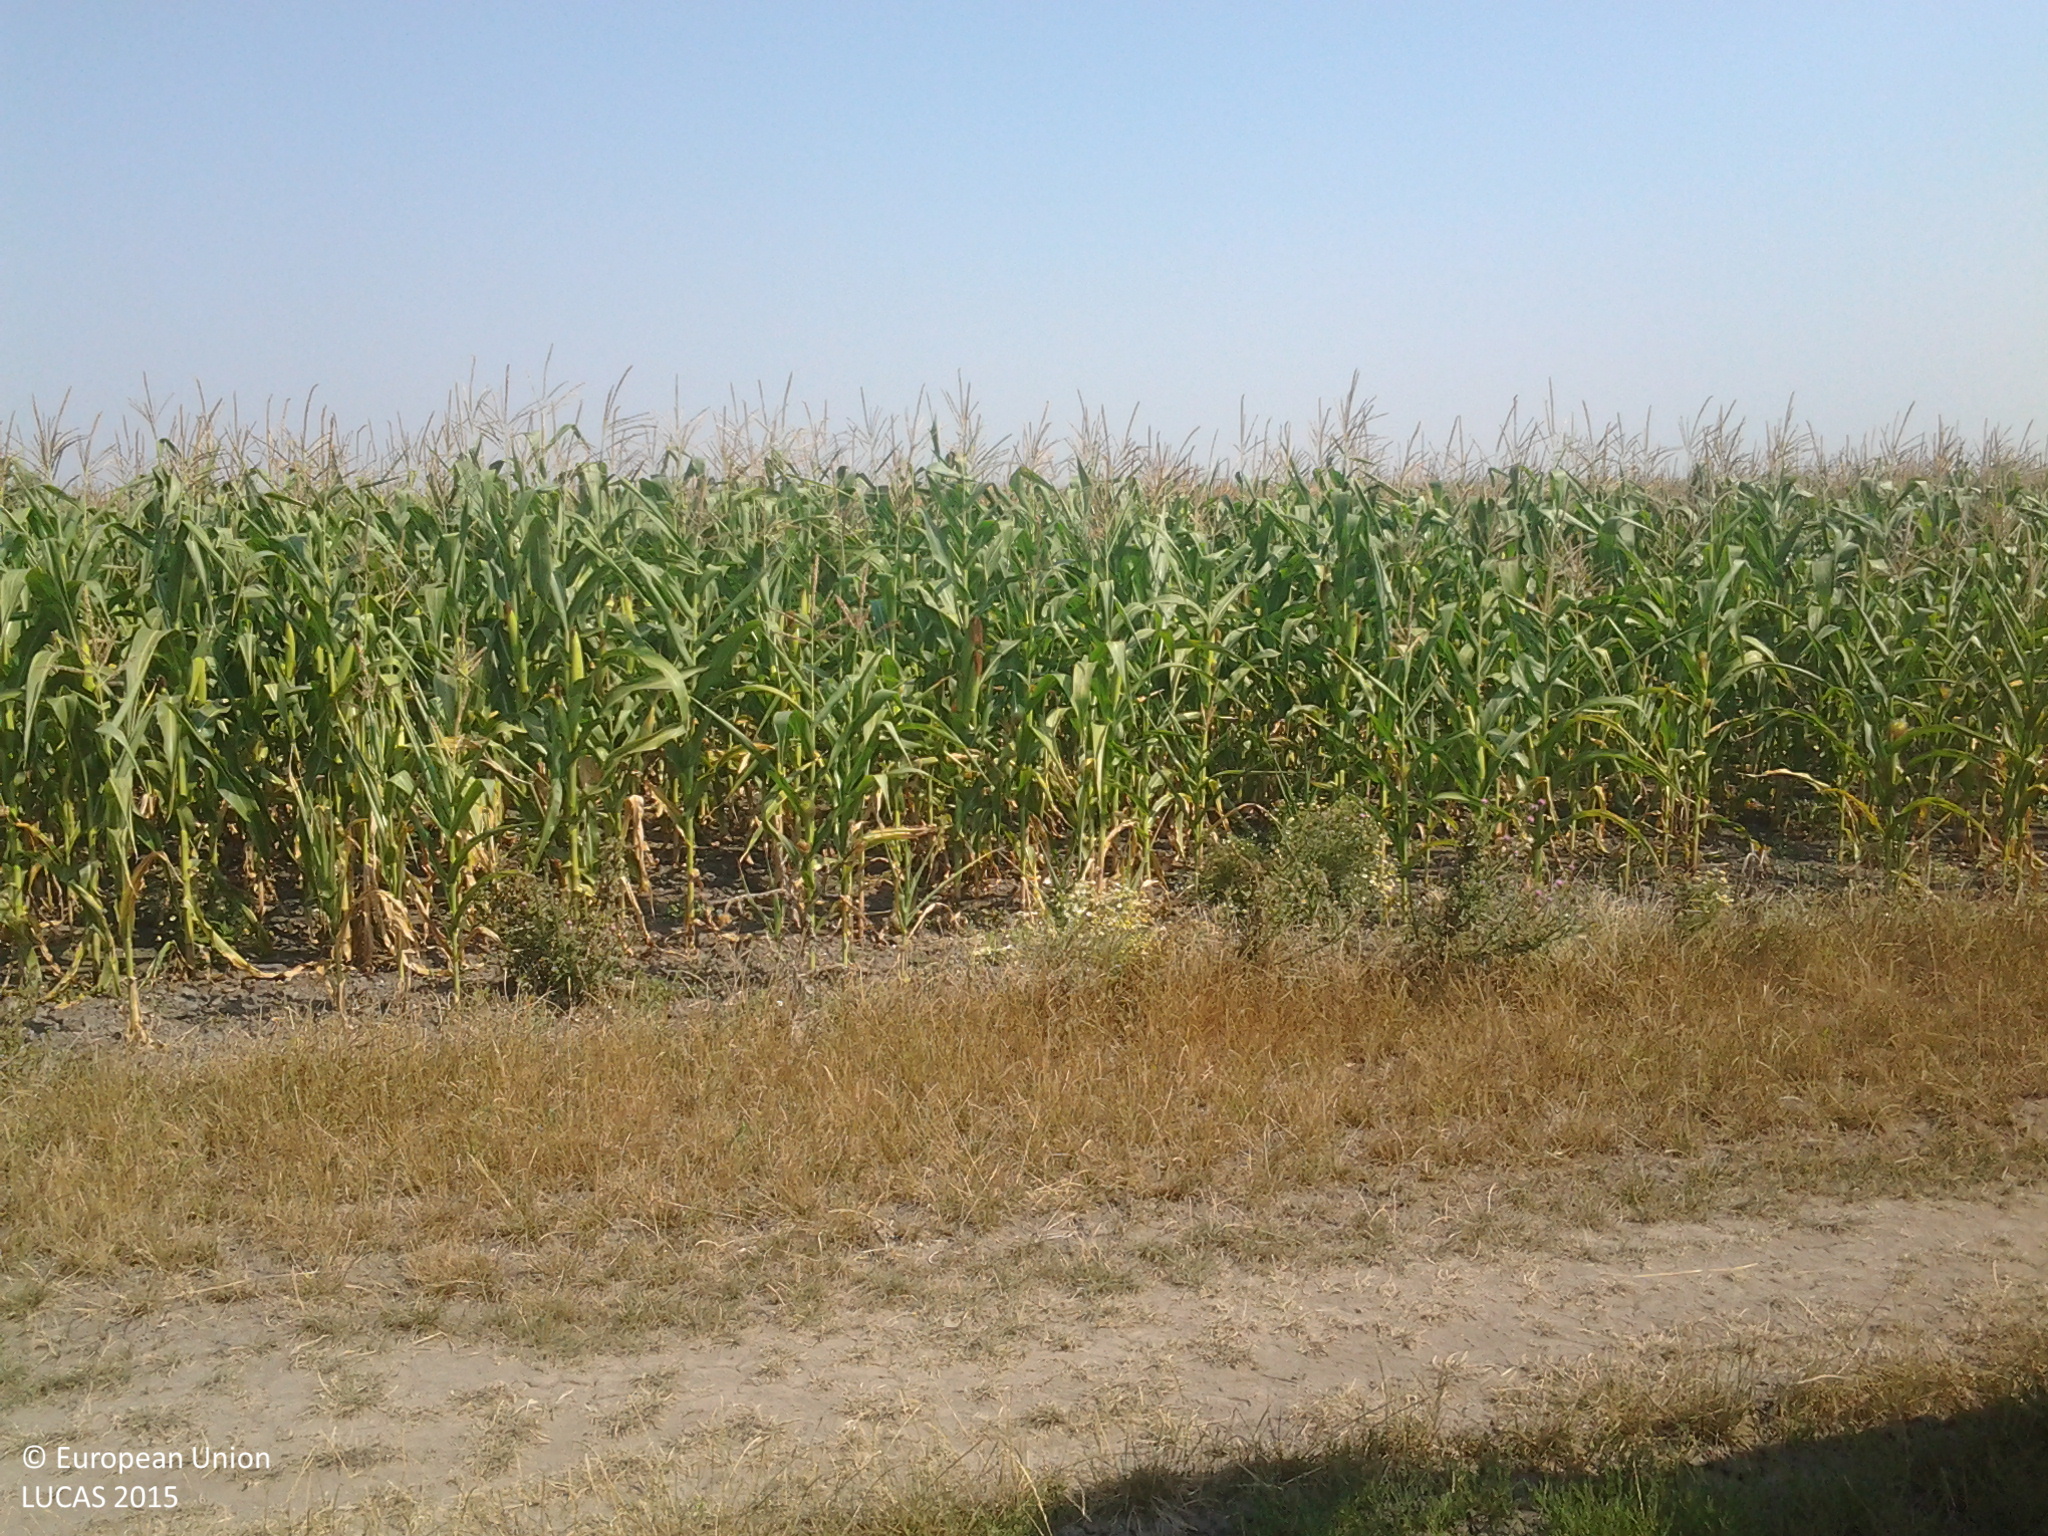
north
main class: Cropland
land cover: Sunflower
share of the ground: > 75 %
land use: Agriculture (excluding fallow land and kitchen gardens)
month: July
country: HU
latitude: 46.8231
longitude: 18.9938
